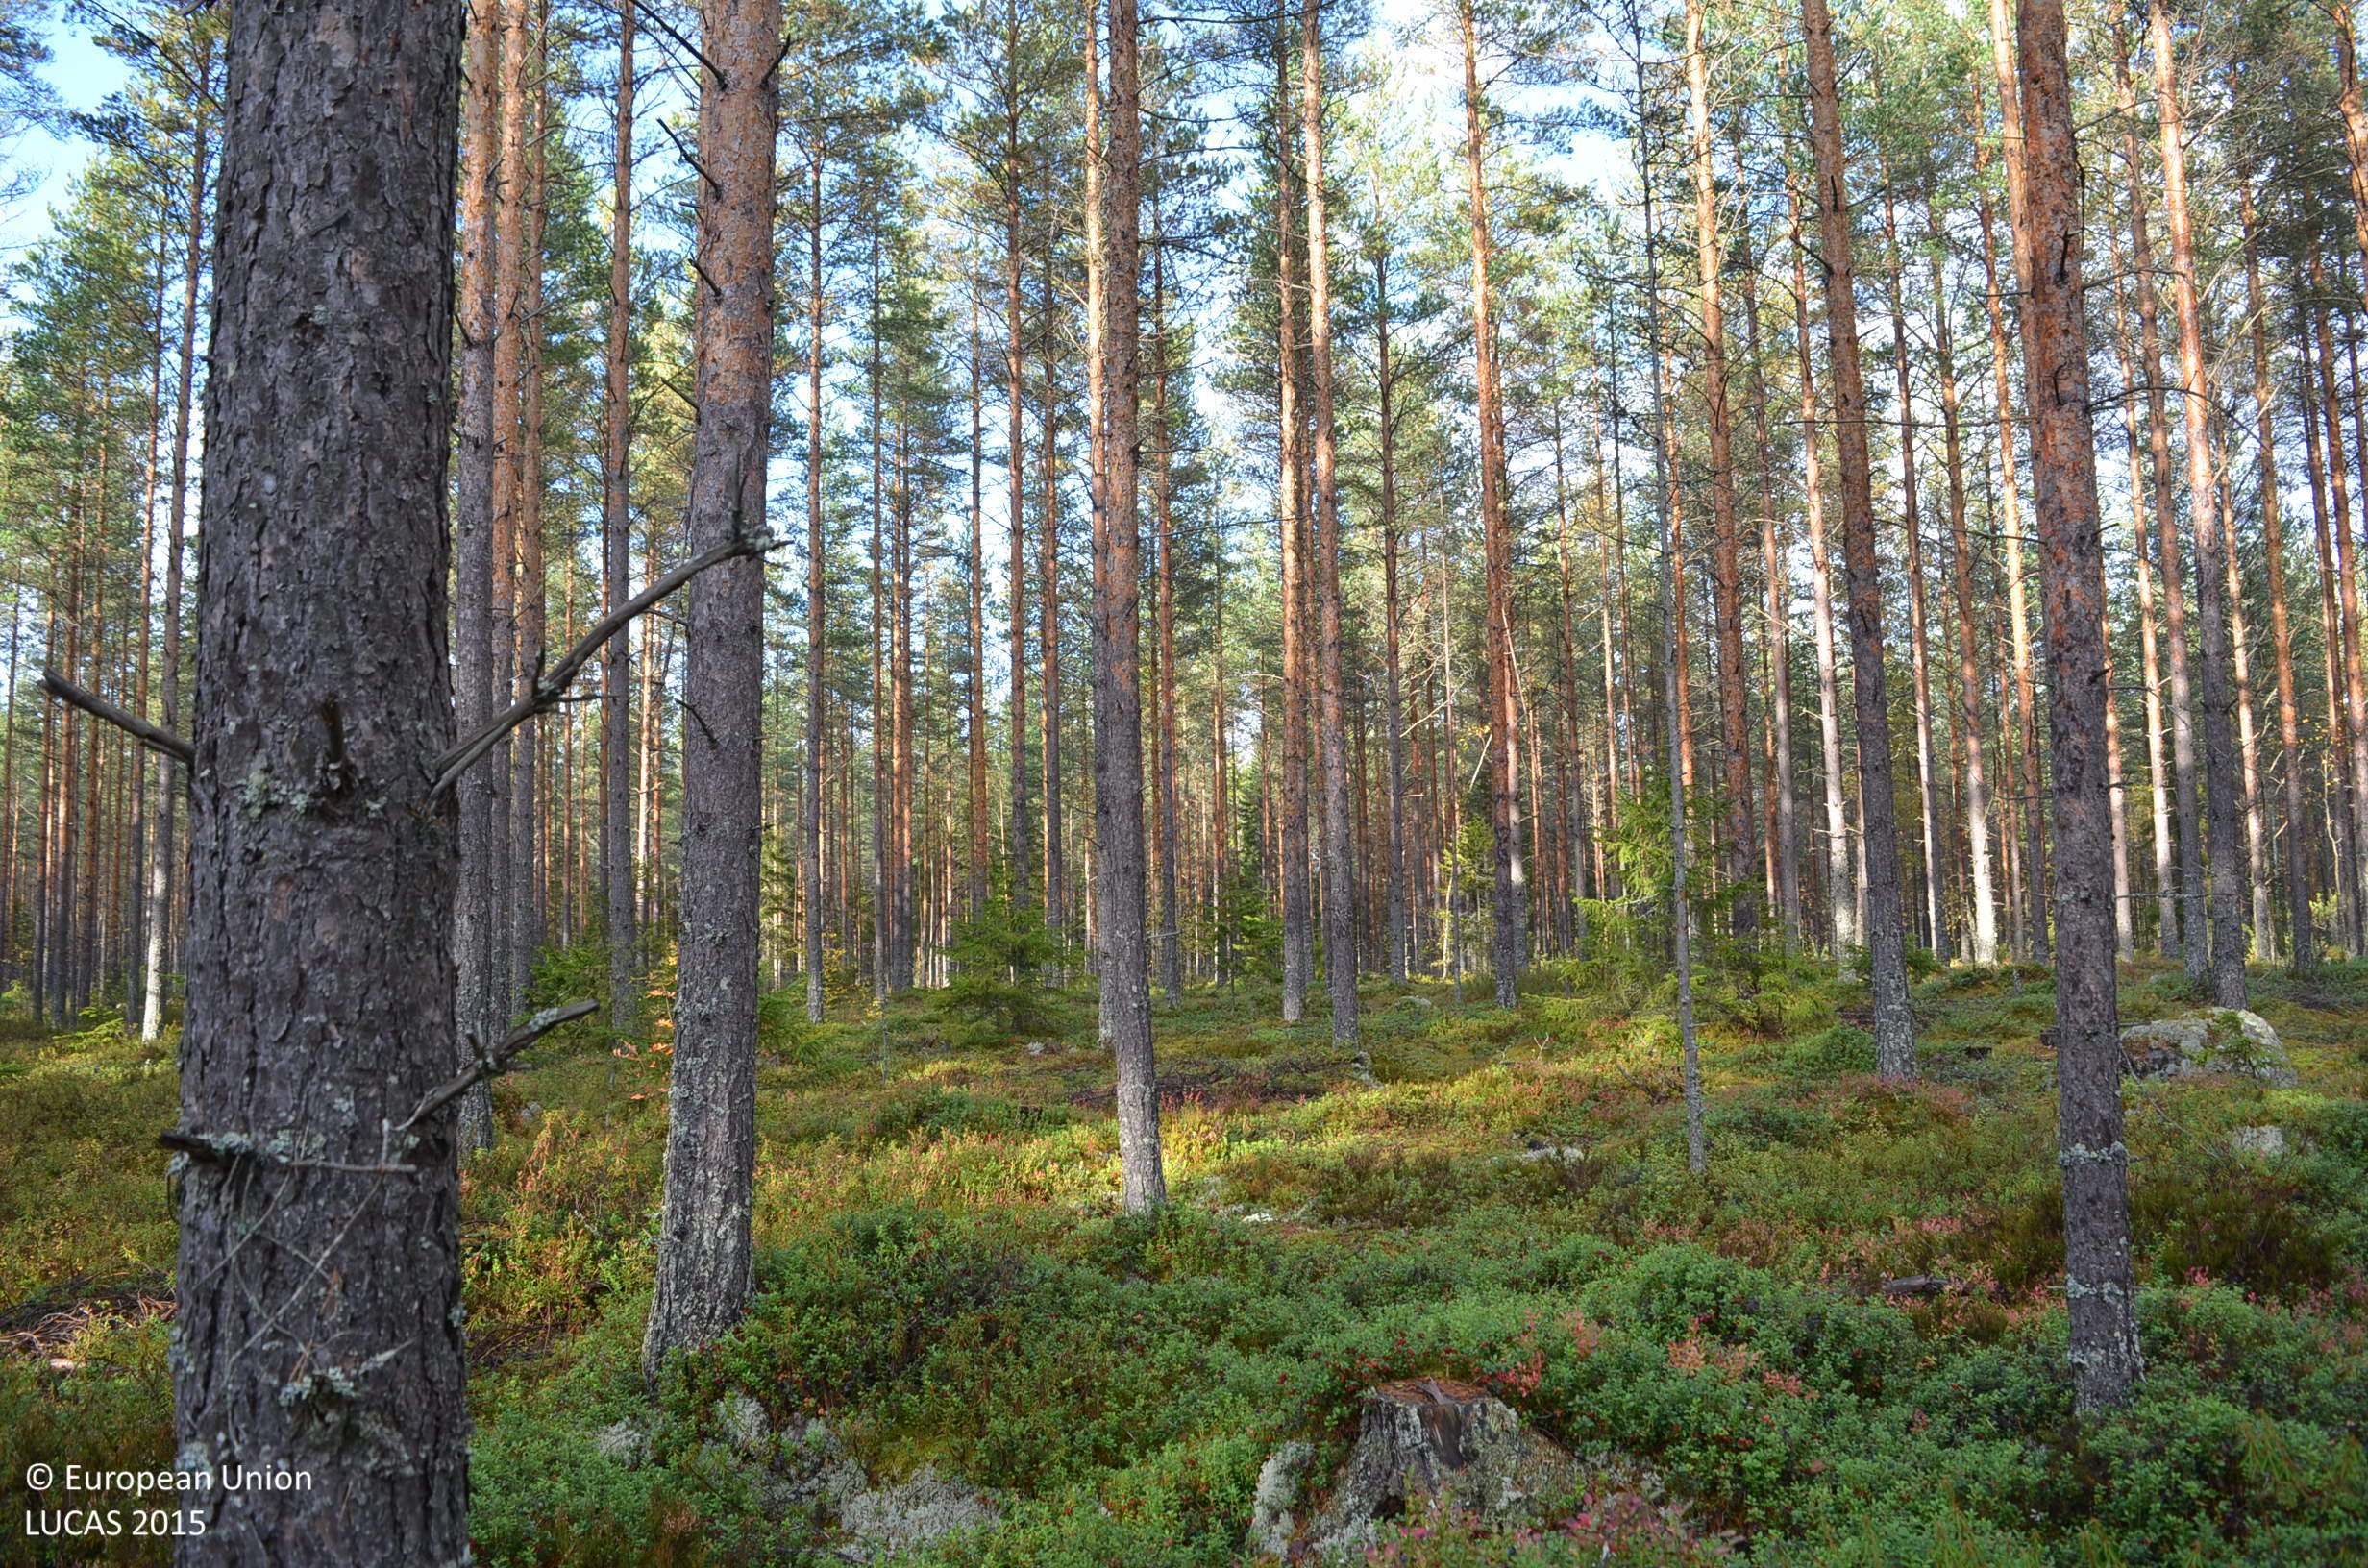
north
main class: Woodland
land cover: Pine dominated coniferous woodland
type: boreal forest
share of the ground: 50 - 75 %
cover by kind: coniferous forest trees 65 %, shrubs 30 %, broadleaved forest trees 5 %
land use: Forestry
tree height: > 5 m
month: September
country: FI
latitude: 62.4519
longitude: 23.5817
